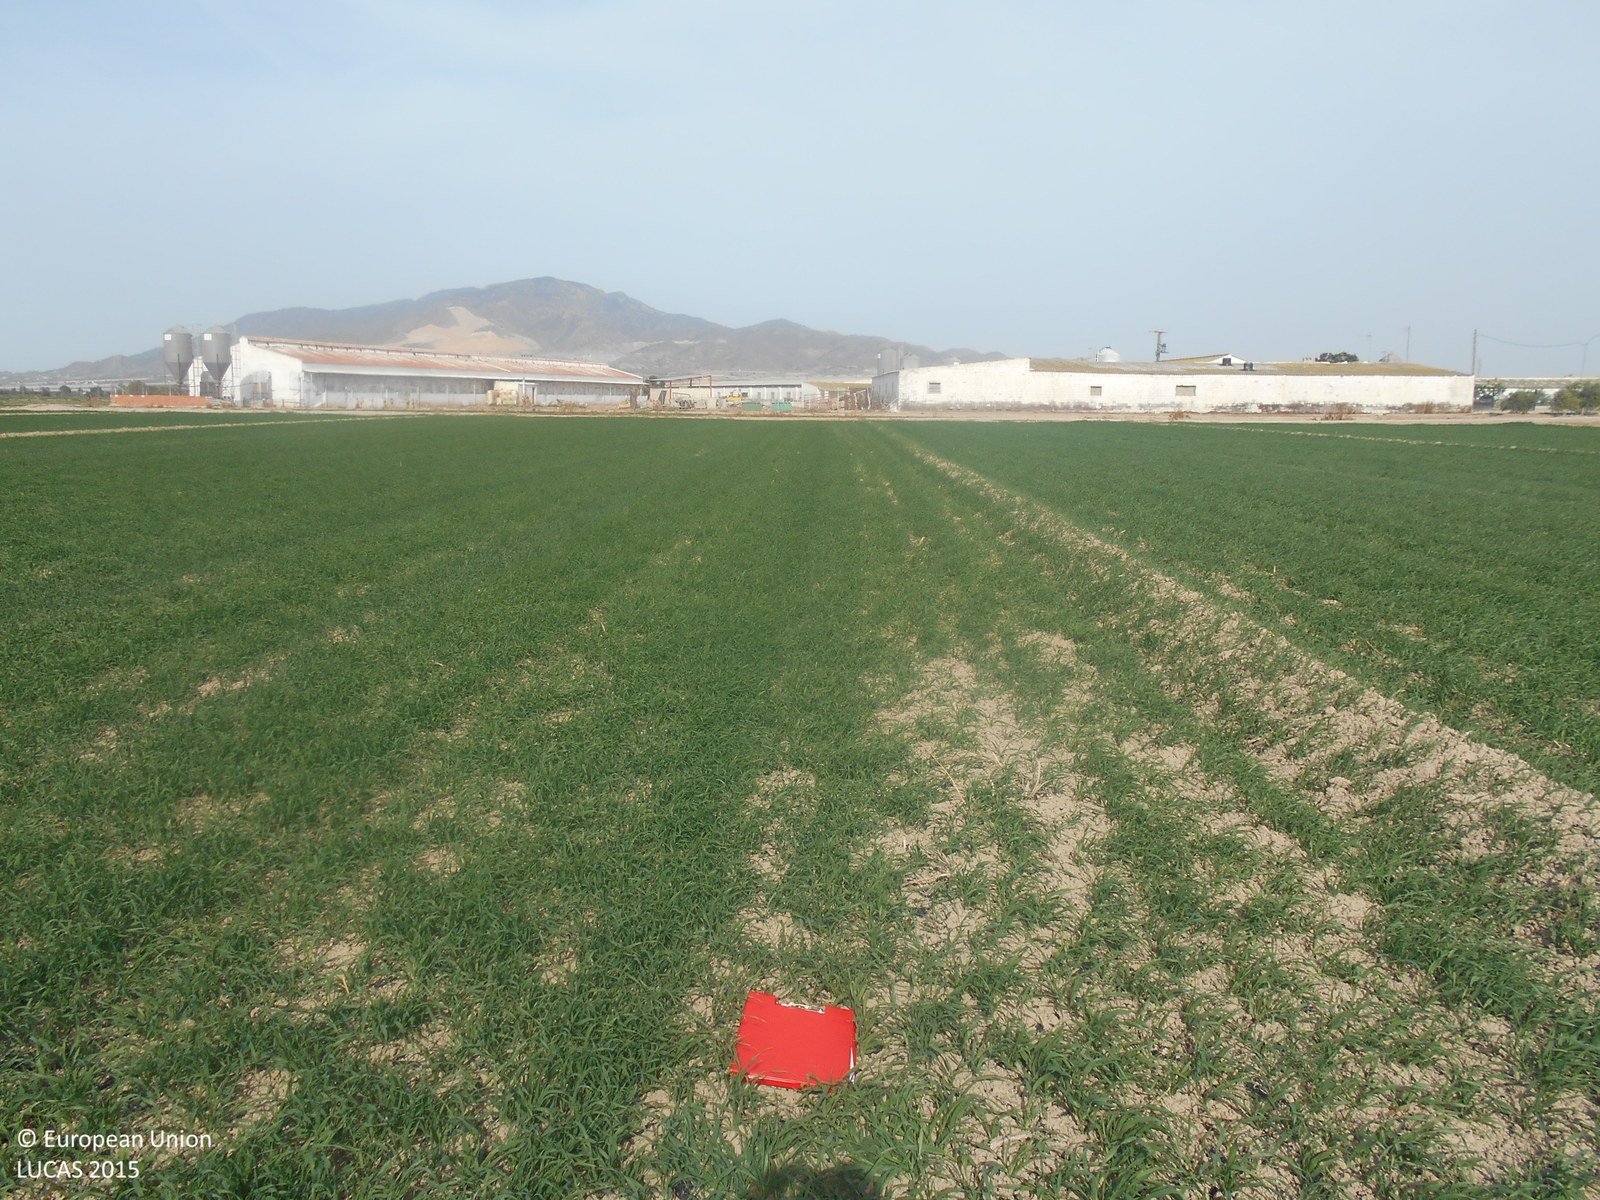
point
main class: Cropland
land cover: Barley
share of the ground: > 75 %
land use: Agriculture (excluding fallow land and kitchen gardens)
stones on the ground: < 10 %
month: April
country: ES
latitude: 37.7920
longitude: -1.3953
